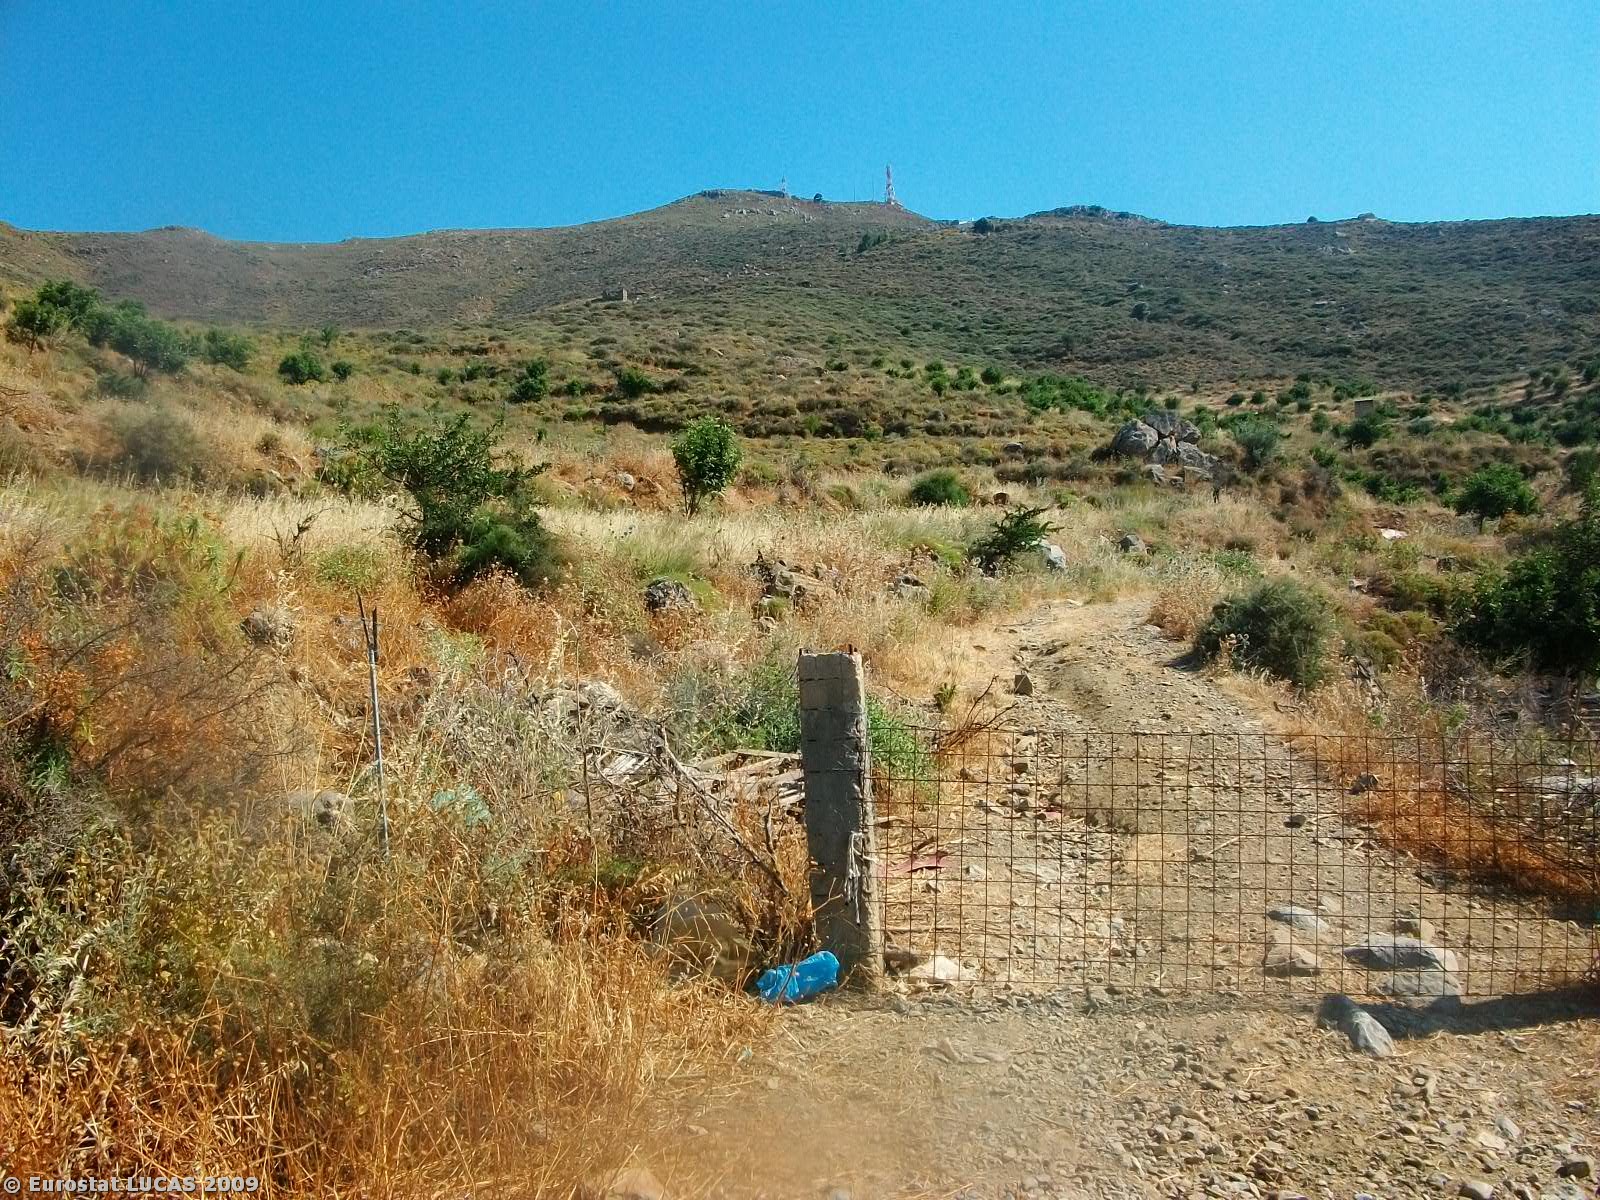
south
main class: Shrubland
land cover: Shrubland with sparse tree cover
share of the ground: > 75 %
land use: Unused
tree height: < 5 m
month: June
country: GR
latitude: 35.0046
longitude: 24.8749
